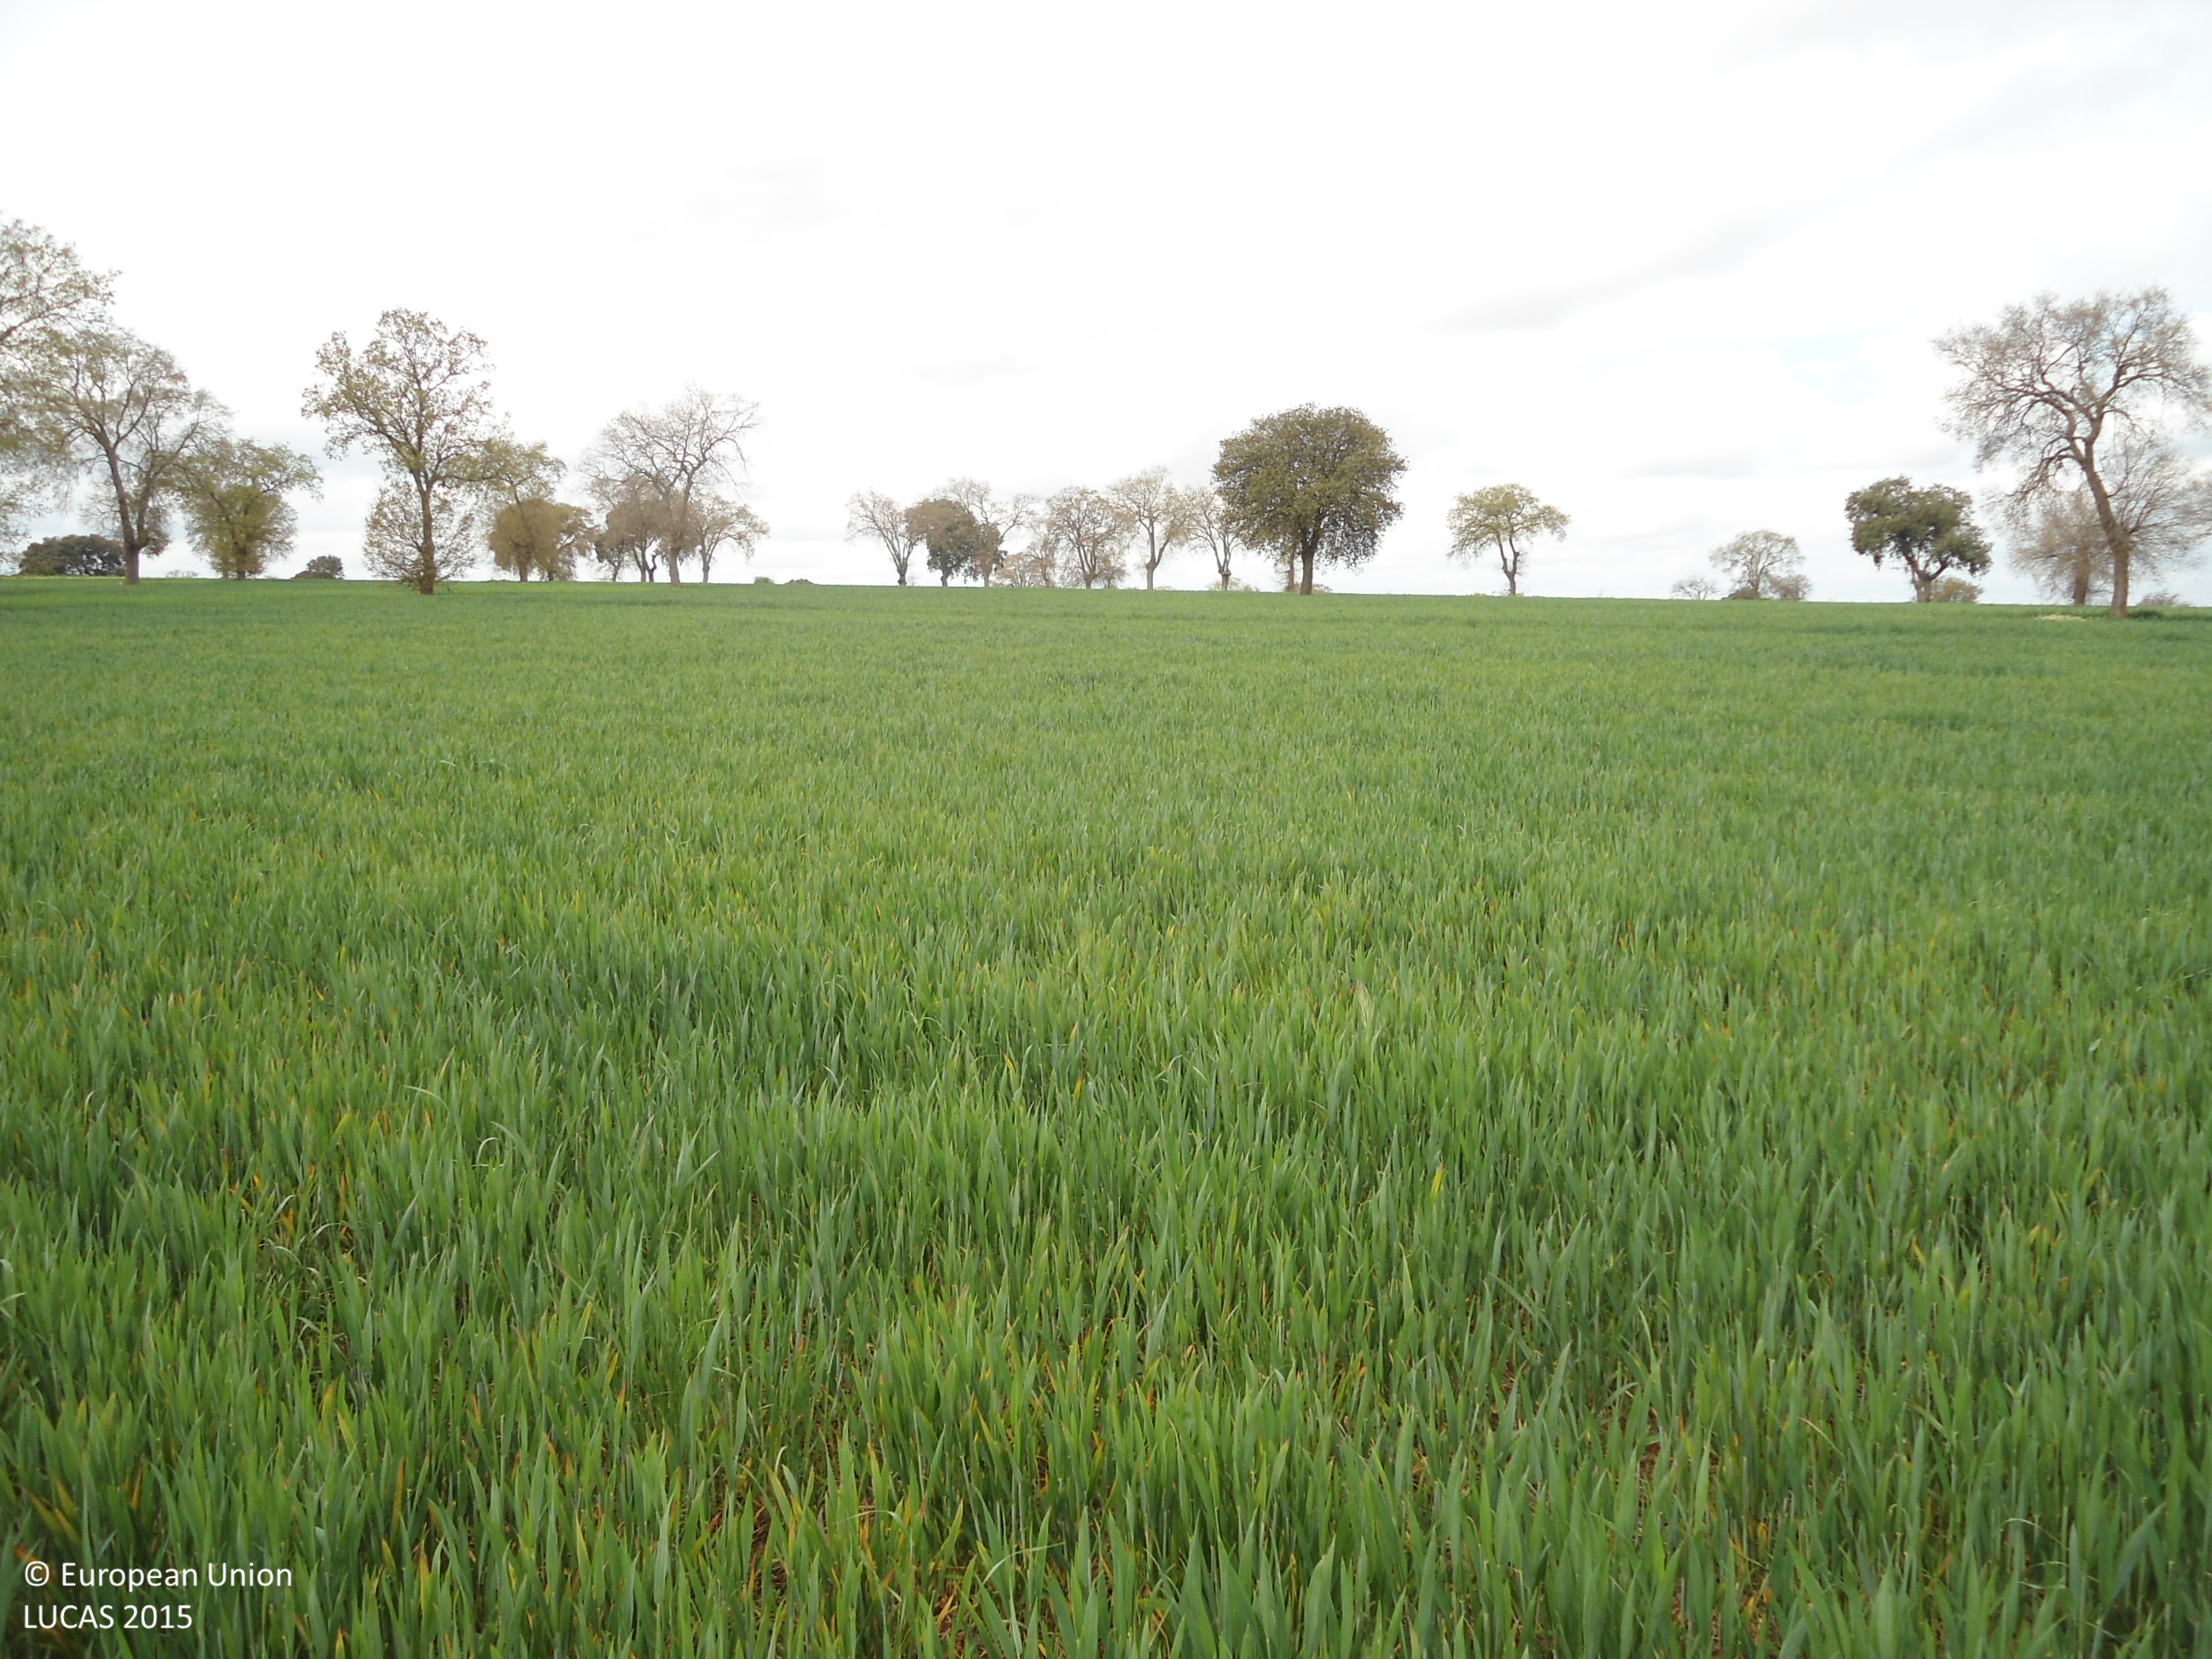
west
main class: Cropland
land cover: Common wheat
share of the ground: > 75 %
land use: Agriculture (excluding fallow land and kitchen gardens)
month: April
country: ES
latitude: 41.6138
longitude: -5.8712
